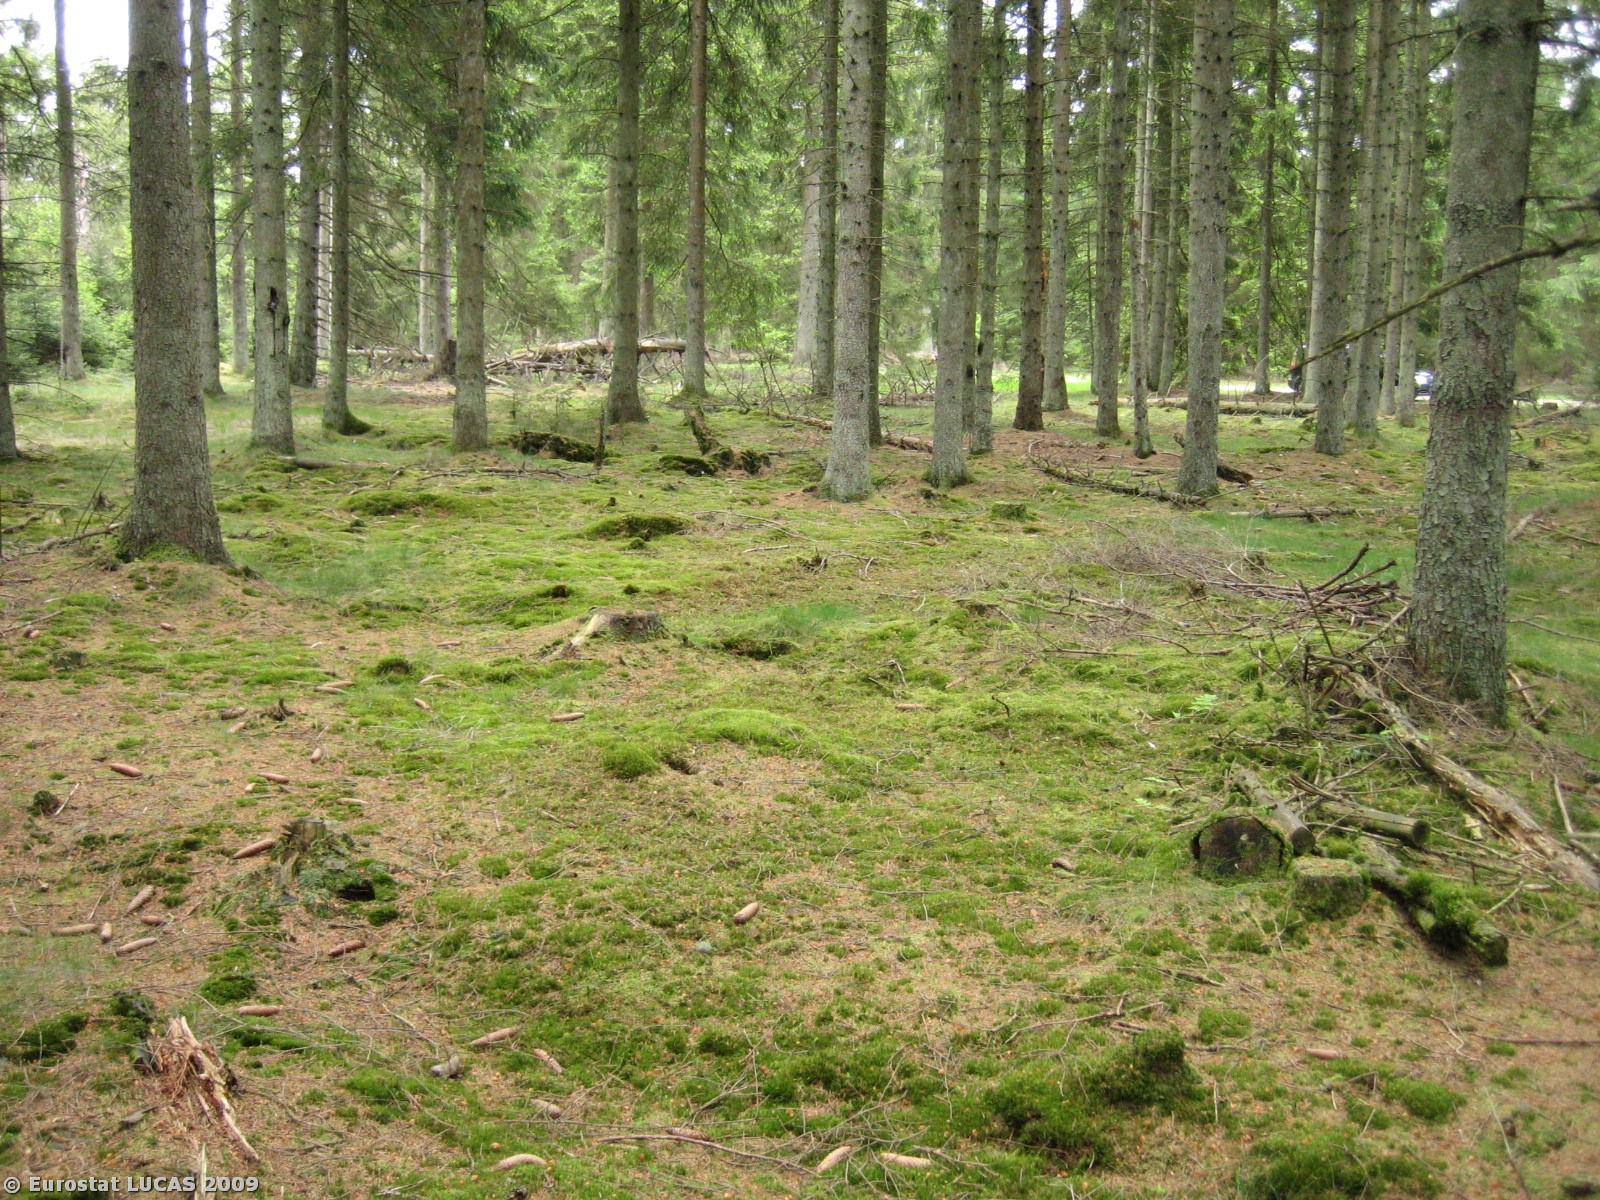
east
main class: Woodland
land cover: Coniferous woodland
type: hemiboreal forest and nemoral coniferous forest and mixed broadleaved-coniferous forest
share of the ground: 50 - 75 %
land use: Forestry
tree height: > 5 m
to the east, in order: Coniferous woodland; Tracks; Coniferous woodland; Grass margins; Tracks; Grass margins; Coniferous woodland; Tracks; Coniferous woodland
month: May
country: DK
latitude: 56.0780
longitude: 9.3099
